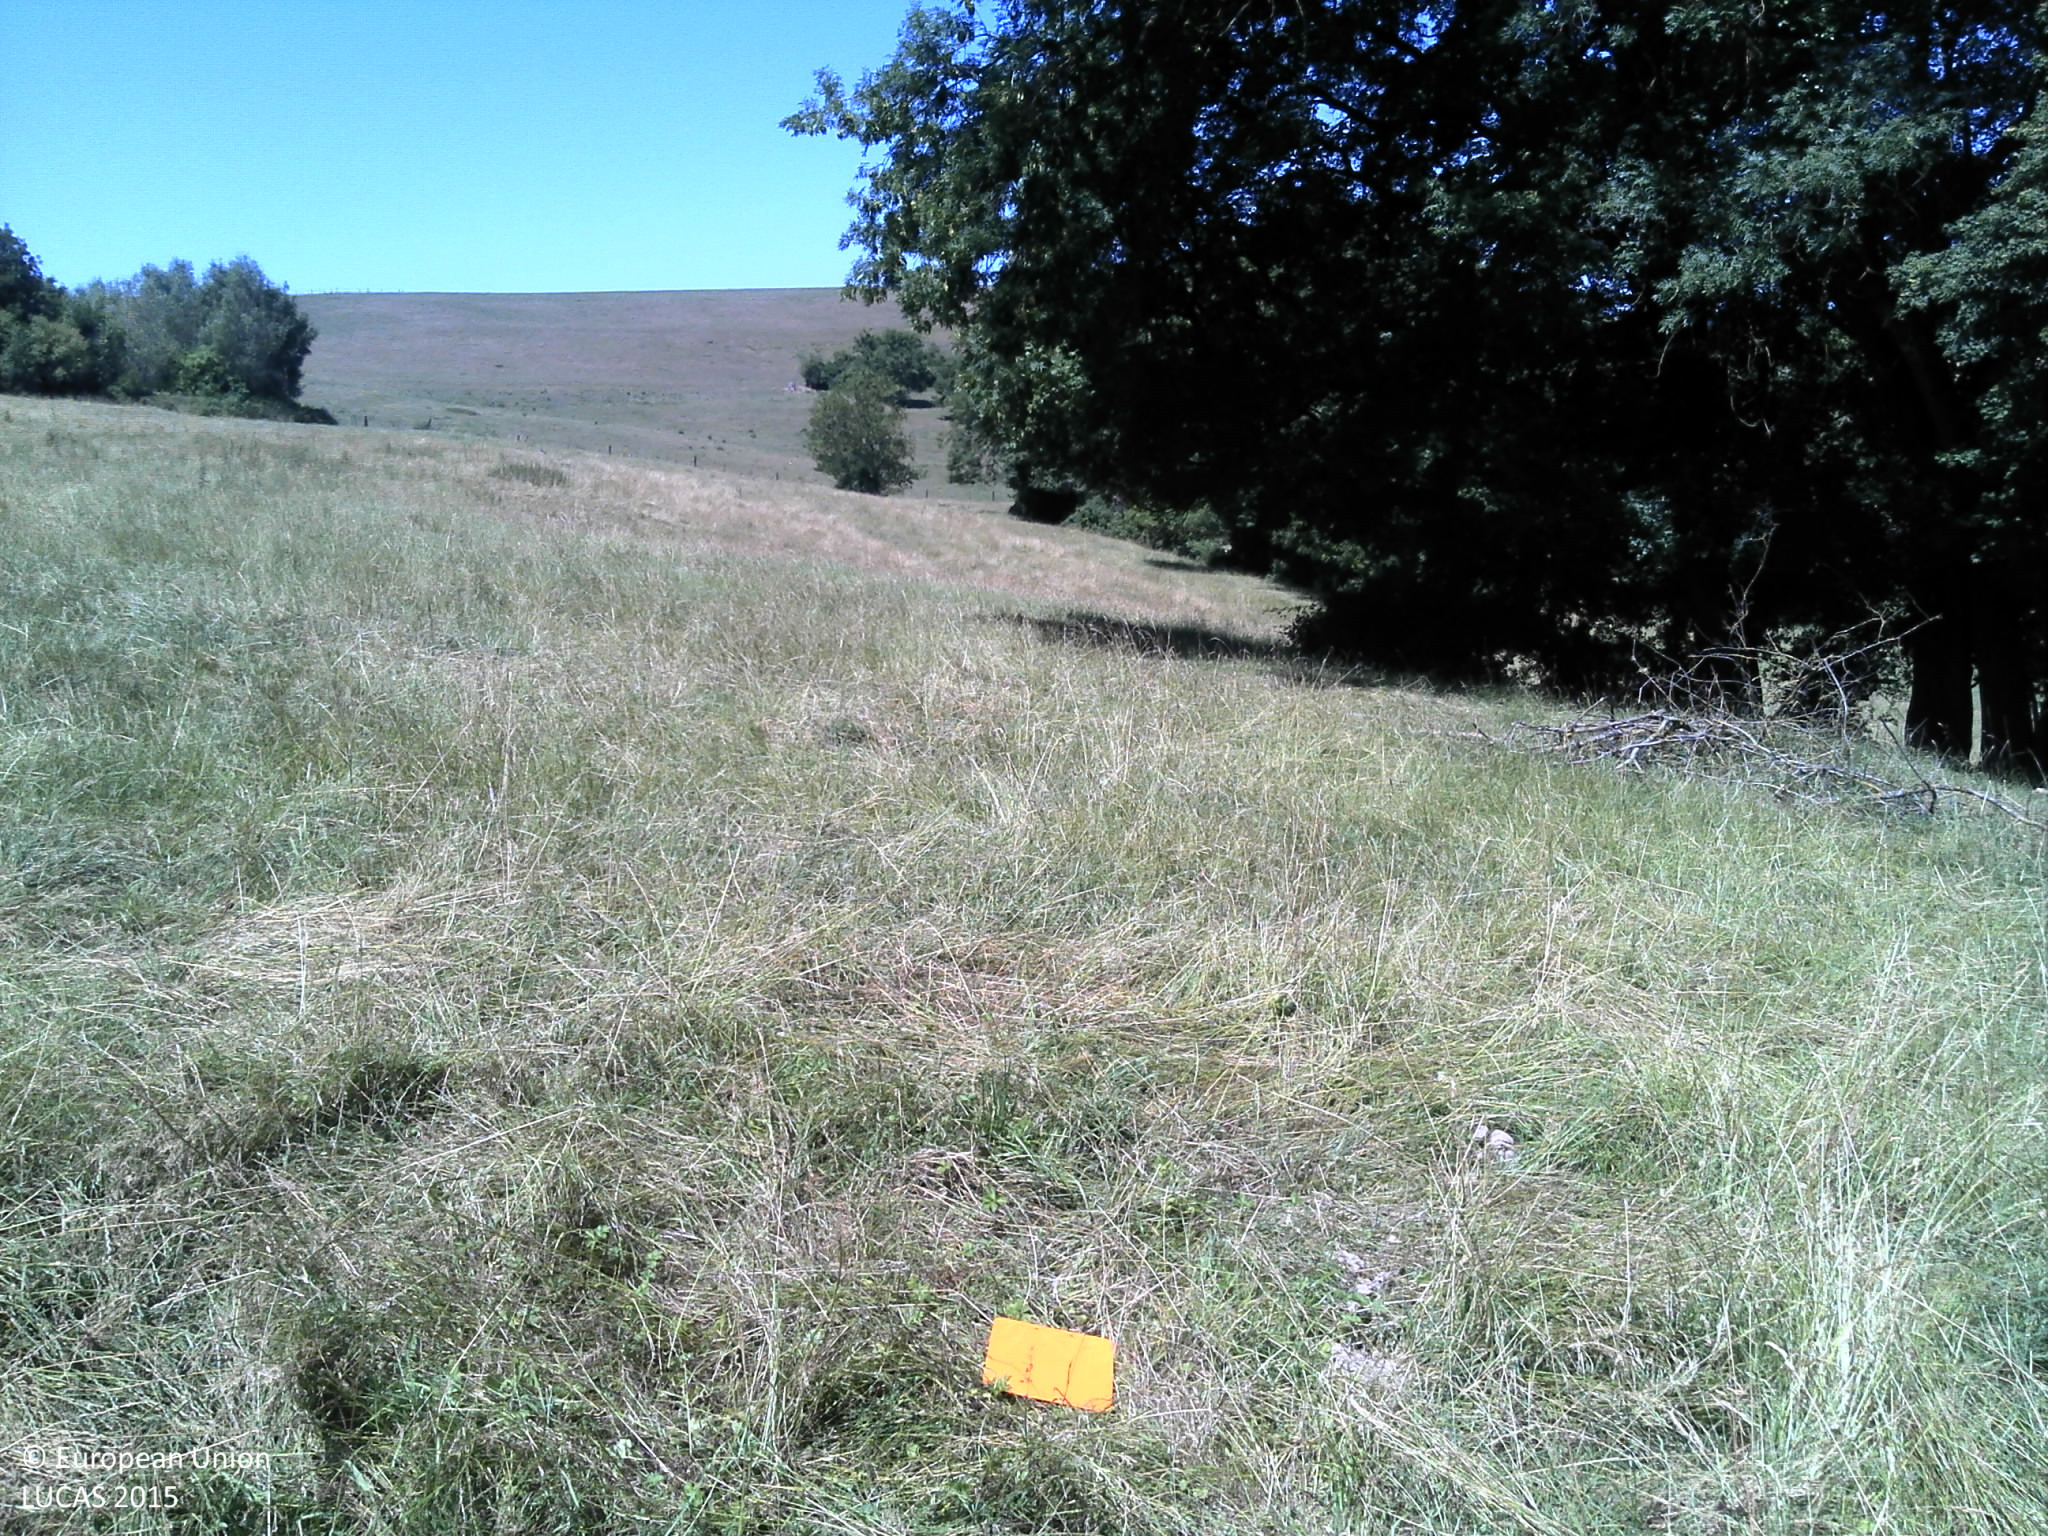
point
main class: Grassland
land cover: Grassland without tree/shrub cover
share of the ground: > 75 %
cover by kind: herbaceous plants 100 %
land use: Agriculture (excluding fallow land and kitchen gardens)
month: July
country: FR
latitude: 49.5744
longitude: 4.7002
